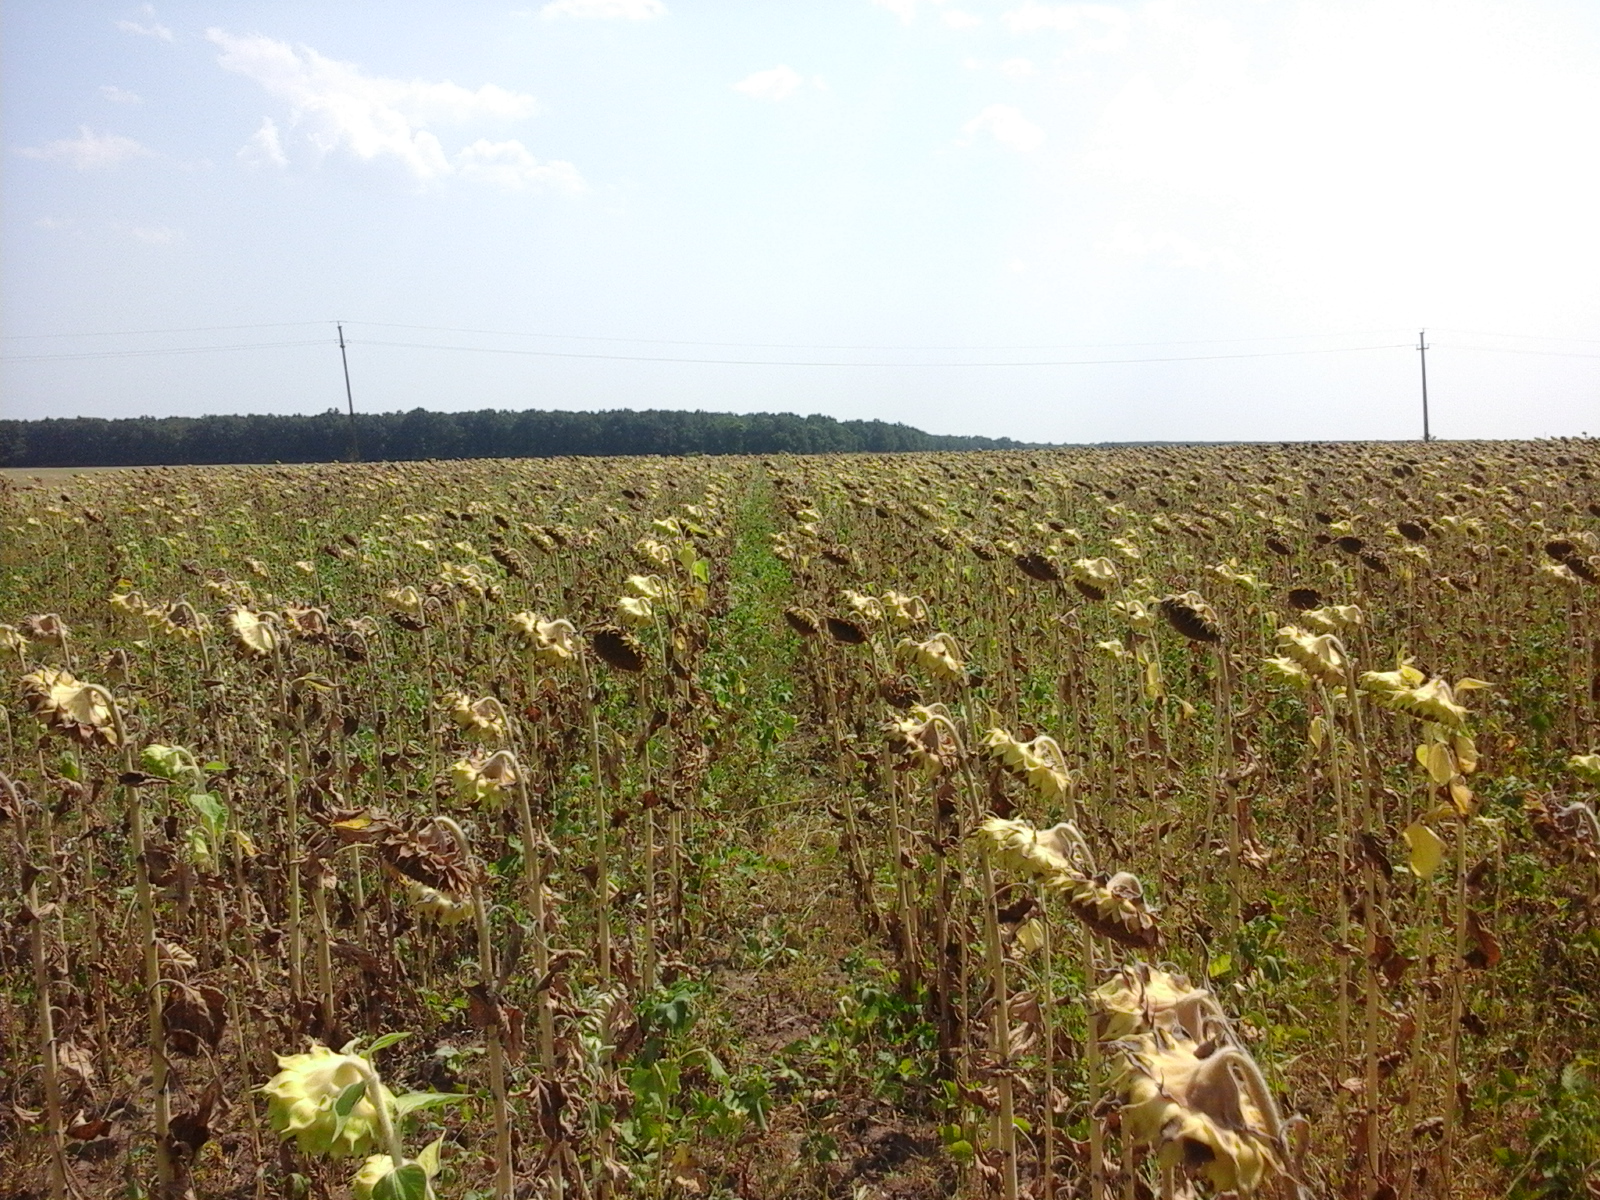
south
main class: Cropland
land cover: Sunflower
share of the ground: 50 - 75 %
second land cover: Spontaneously vegetated surfaces
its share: 25 - 50 %
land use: Agriculture (excluding fallow land and kitchen gardens)
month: August
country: RO
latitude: 44.1733
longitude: 23.5213
